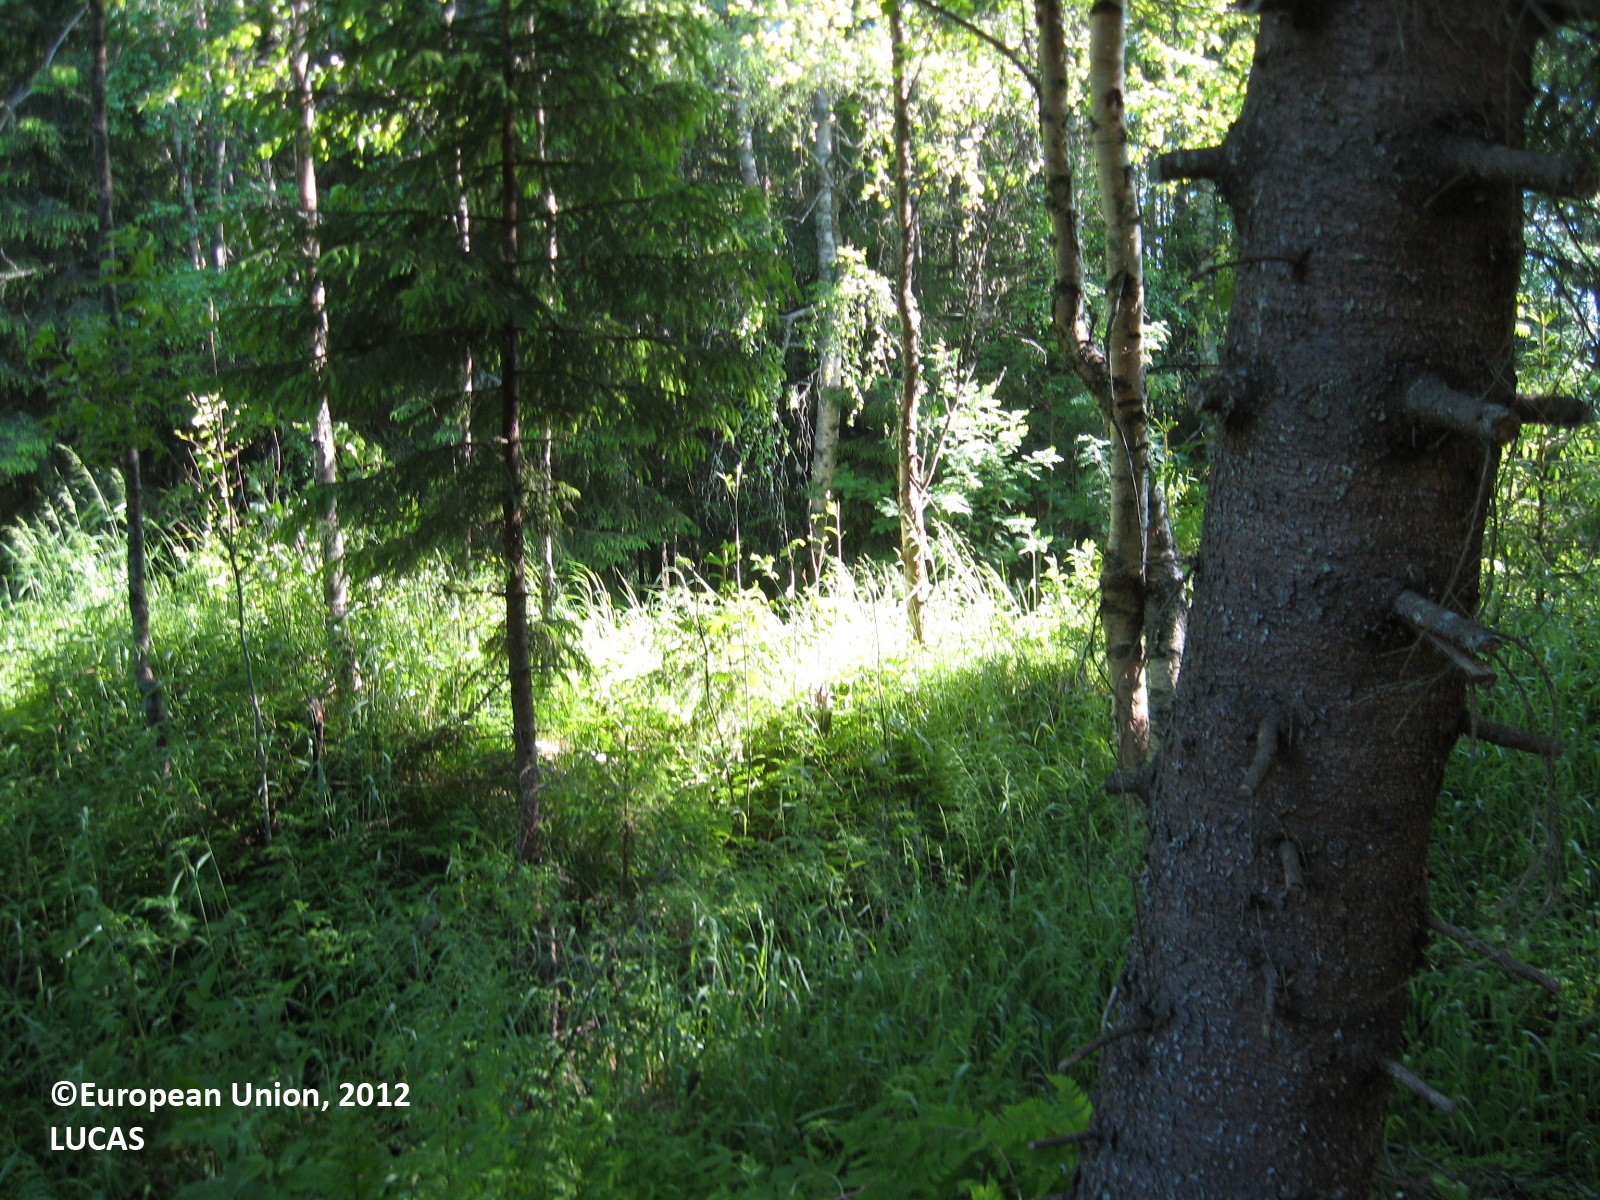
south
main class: Woodland
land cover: Other mixed woodland
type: boreal forest
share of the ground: > 75 %
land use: Forestry
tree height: > 5 m
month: June
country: FI
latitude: 62.9676
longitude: 21.8172
